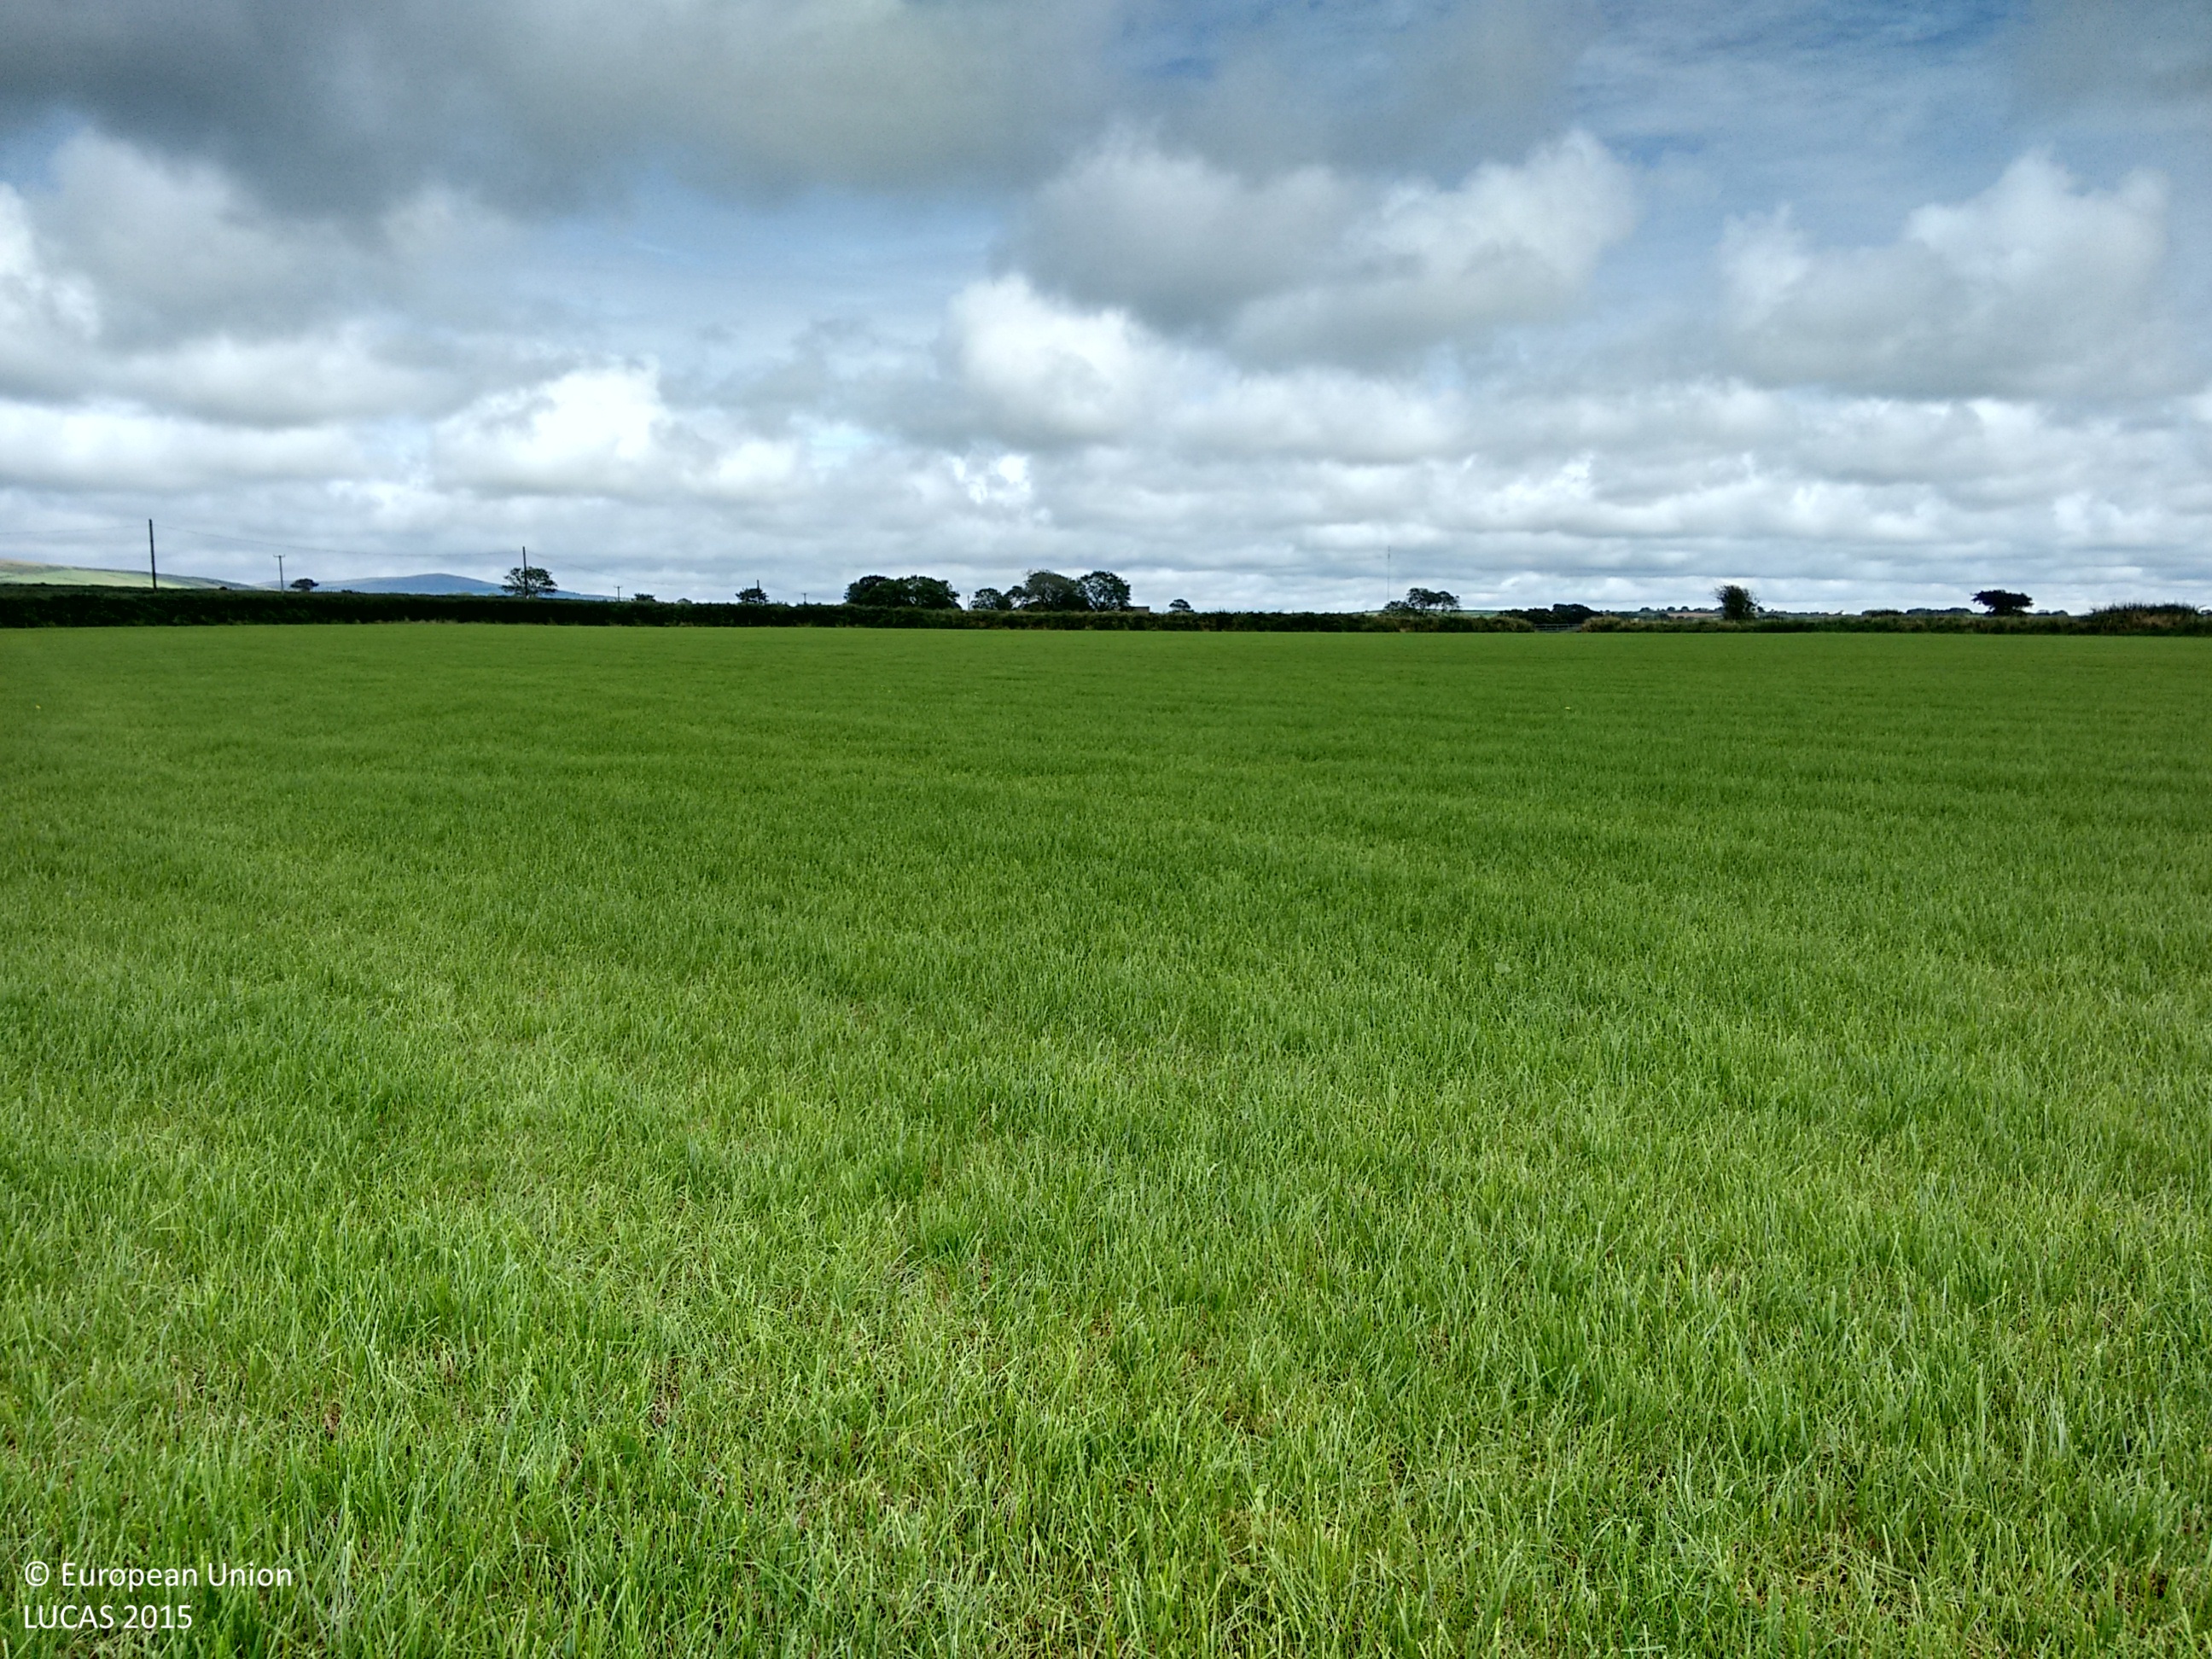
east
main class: Cropland
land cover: Temporary grasslands
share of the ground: > 75 %
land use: Agriculture (excluding fallow land and kitchen gardens)
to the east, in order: Temporary grasslands; Managed hedges; Fences; Grass margins; Temporary grasslands
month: August
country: GB
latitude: 51.9022
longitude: -4.9256
